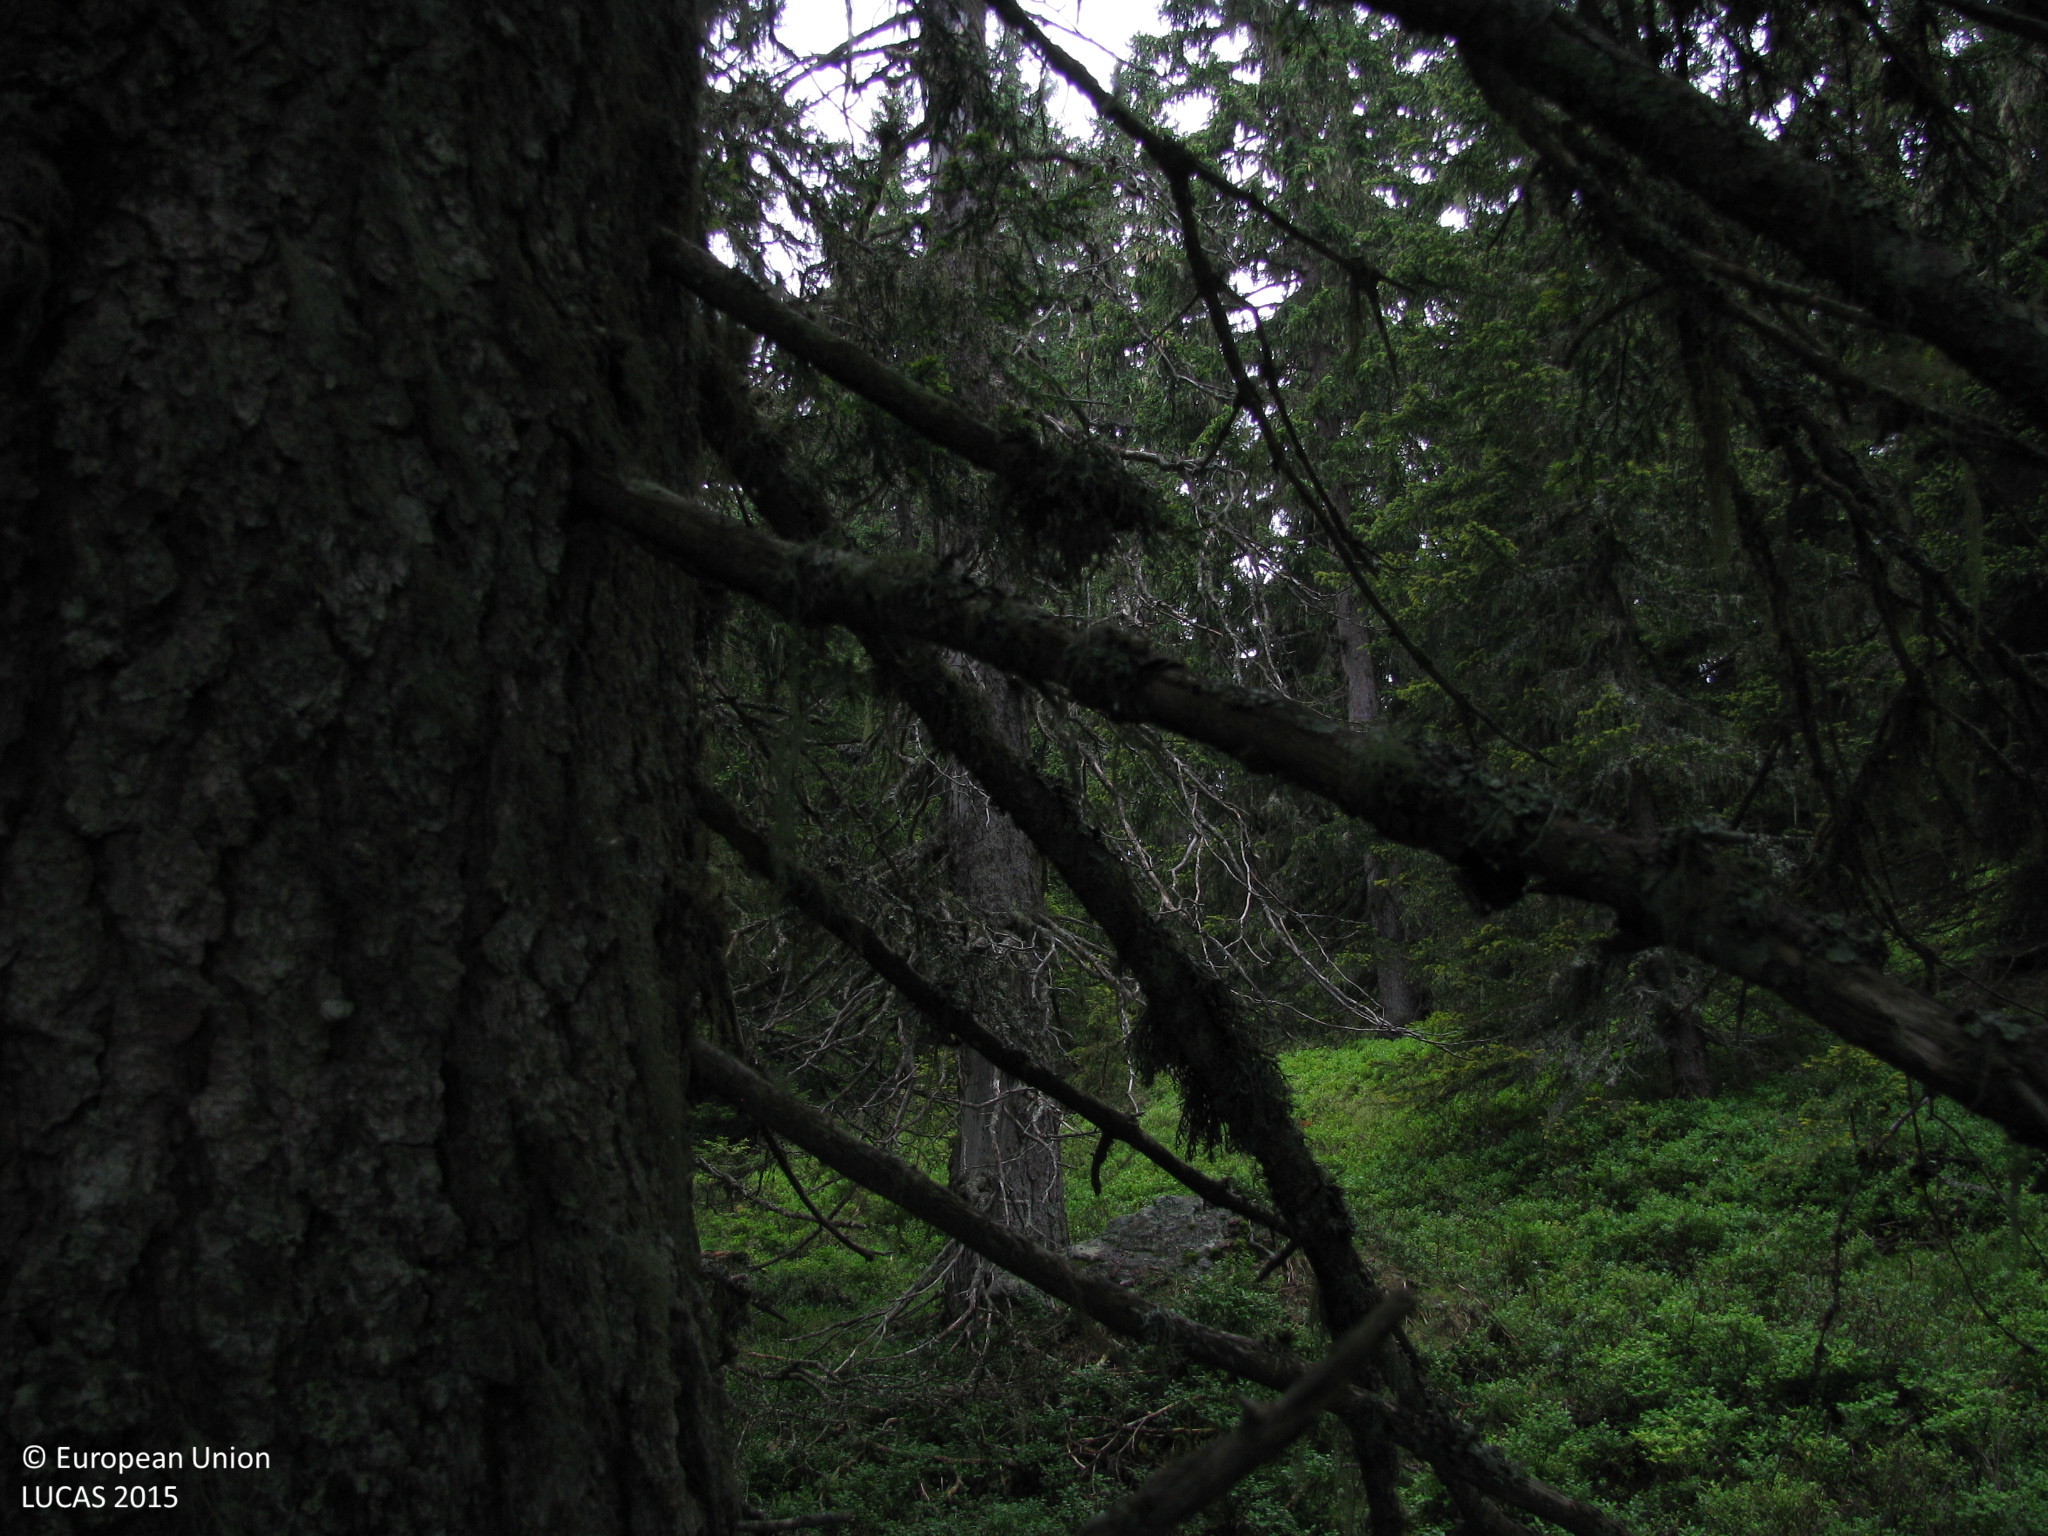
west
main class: Woodland
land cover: Spruce dominated coniferous woodland
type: alpine coniferous forest
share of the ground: 50 - 75 %
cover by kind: coniferous forest trees 65 %, herbaceous plants 30 %, lichens and mosses 5 %
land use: Forestry
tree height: > 5 m
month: July
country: AT
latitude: 46.8720
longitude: 12.8446
